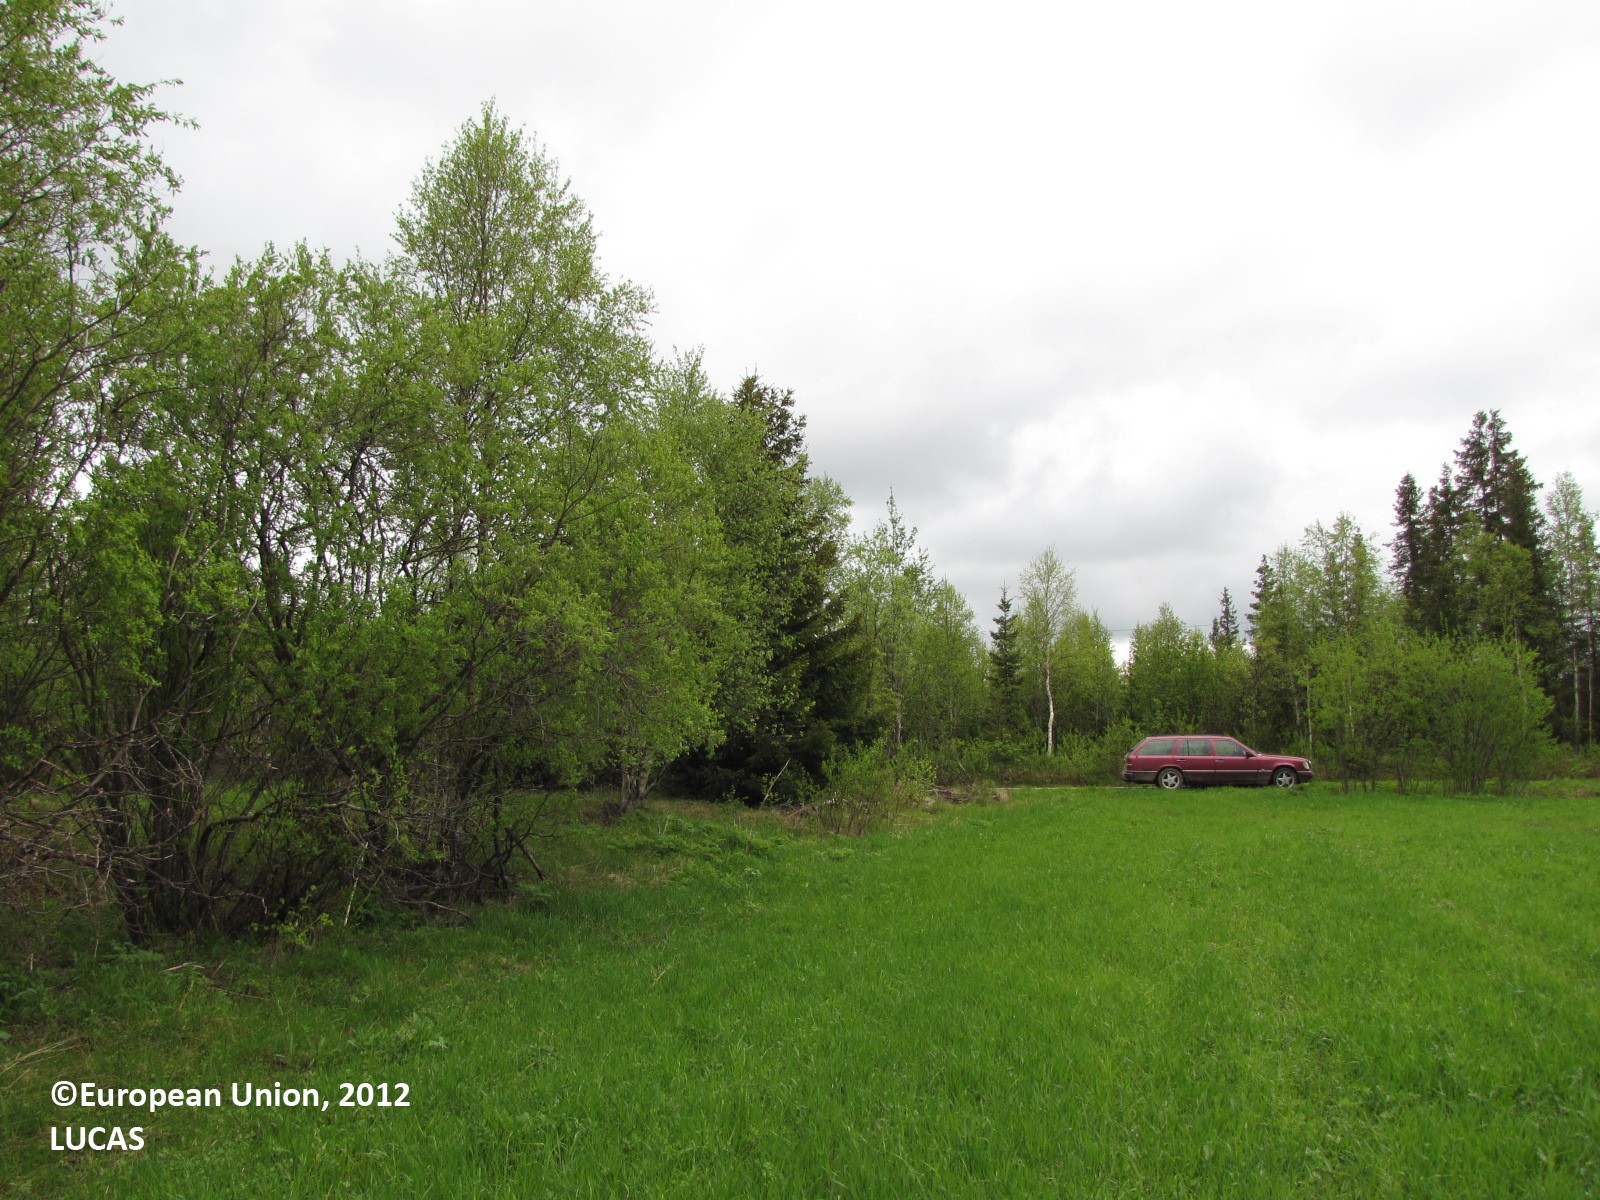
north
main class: Grassland
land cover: Grassland without tree/shrub cover
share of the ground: > 75 %
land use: Agriculture (excluding fallow land and kitchen gardens)
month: June
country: FI
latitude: 65.9492
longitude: 24.4094
